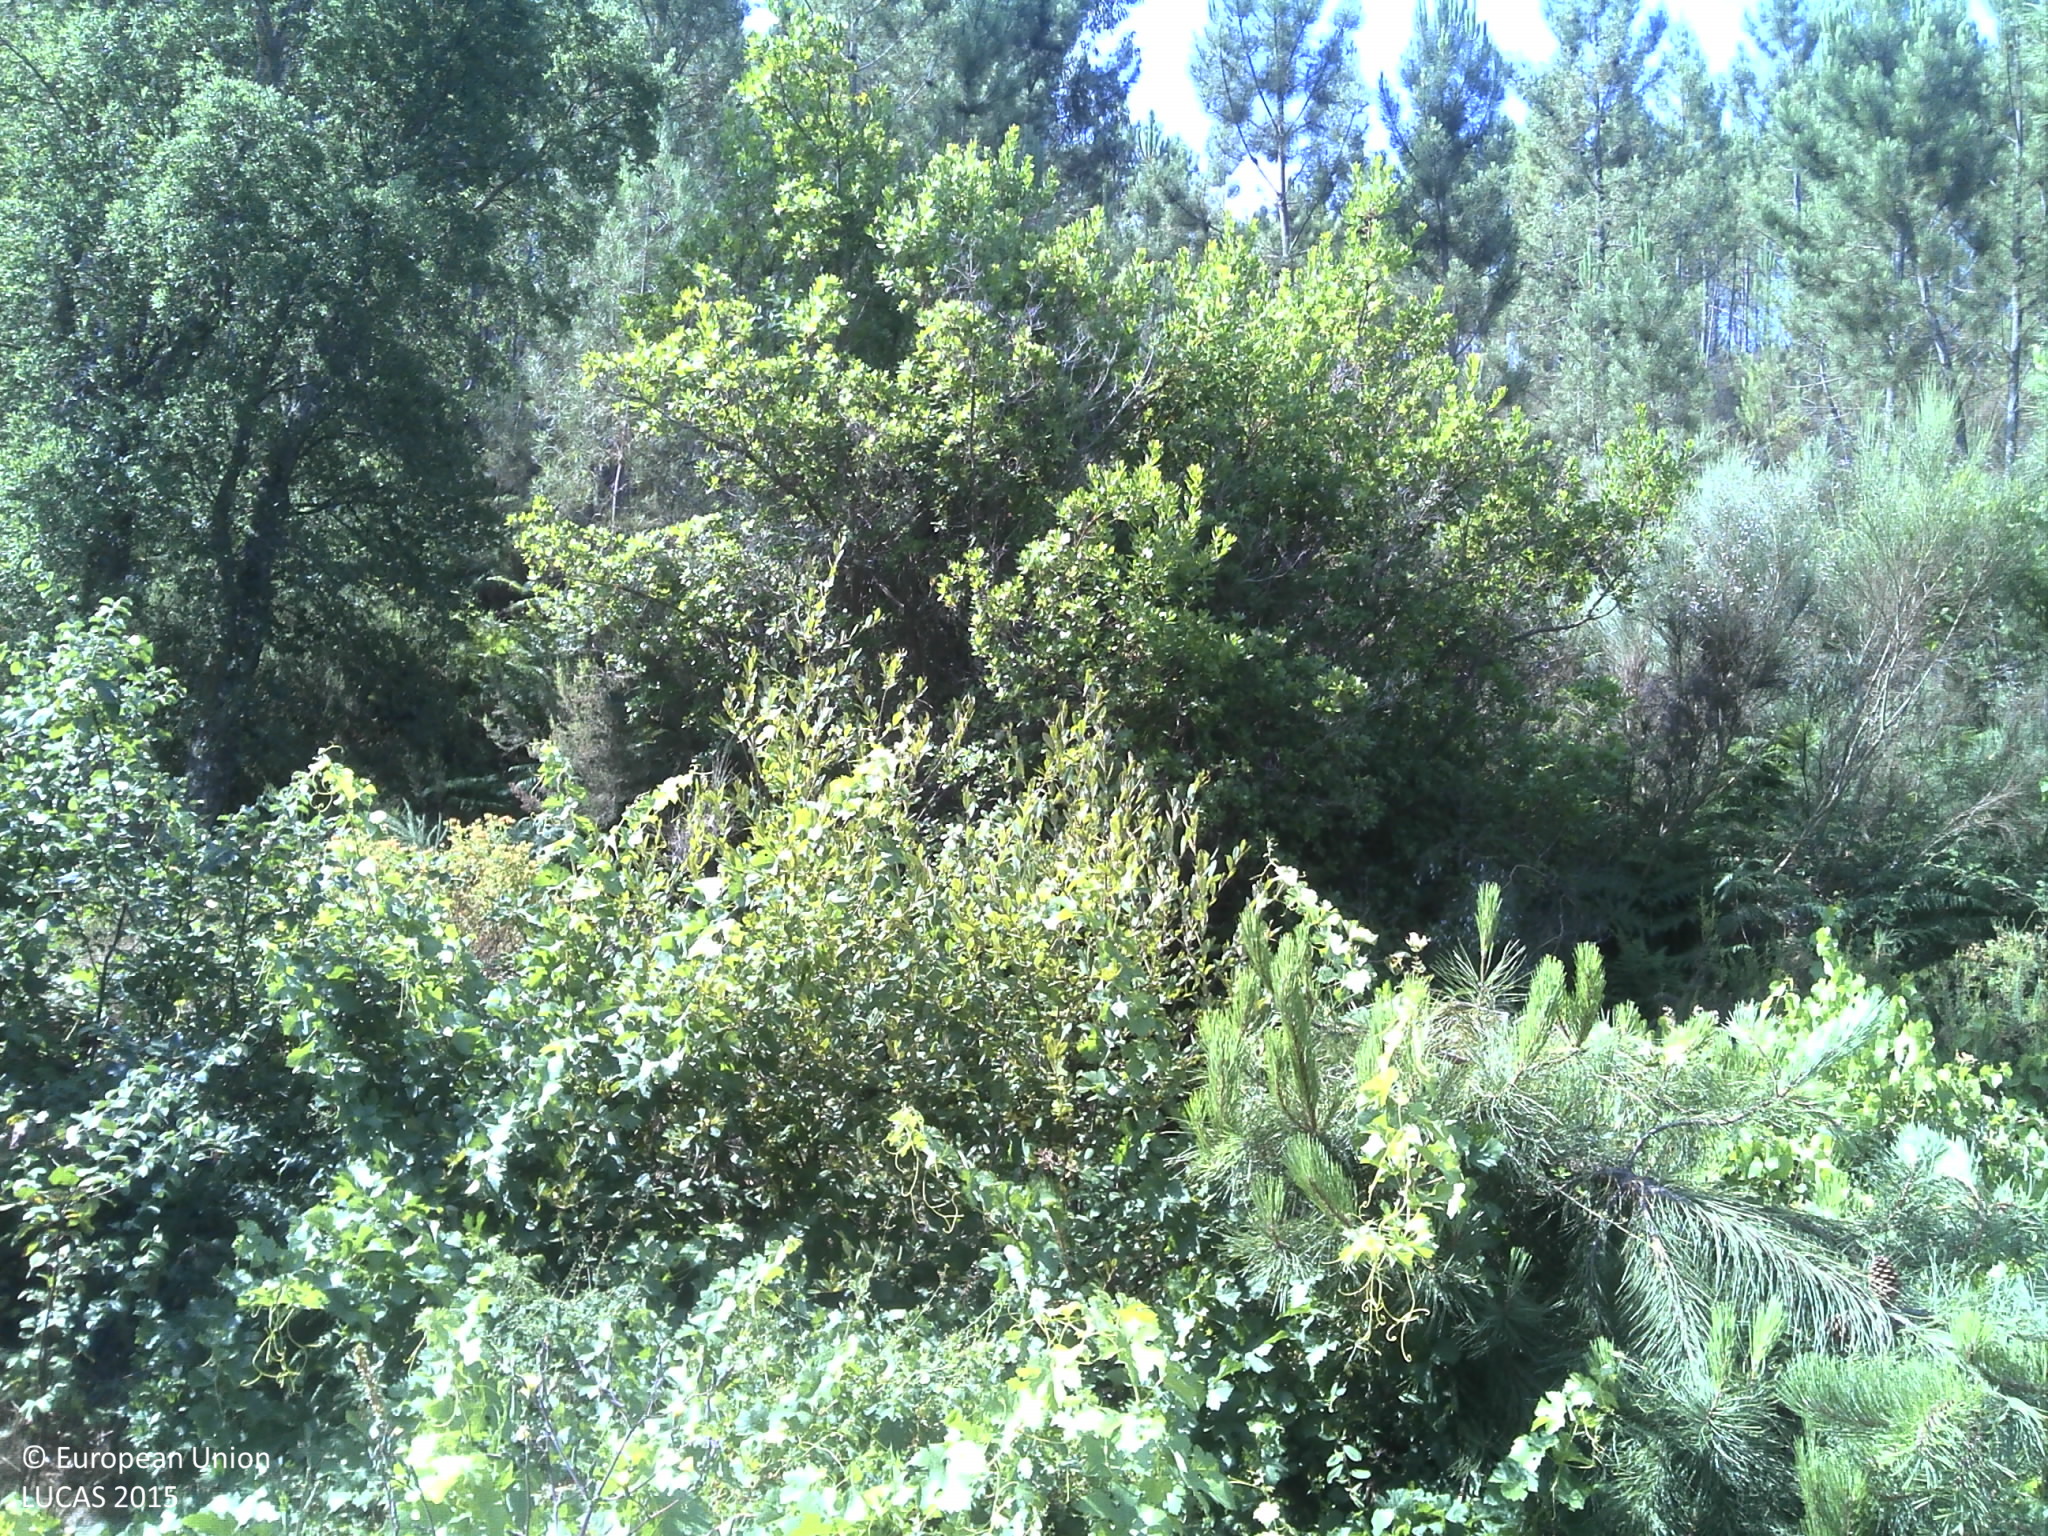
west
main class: Woodland
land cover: Pine dominated coniferous woodland
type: coniferous forest of the mediterranean region
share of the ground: 25 - 50 %
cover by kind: shrubs 60 %, coniferous forest trees 35 %, unconsolidated bare surface 5 %
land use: Forestry
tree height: > 5 m
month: July
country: PT
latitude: 40.0993
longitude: -7.7167
